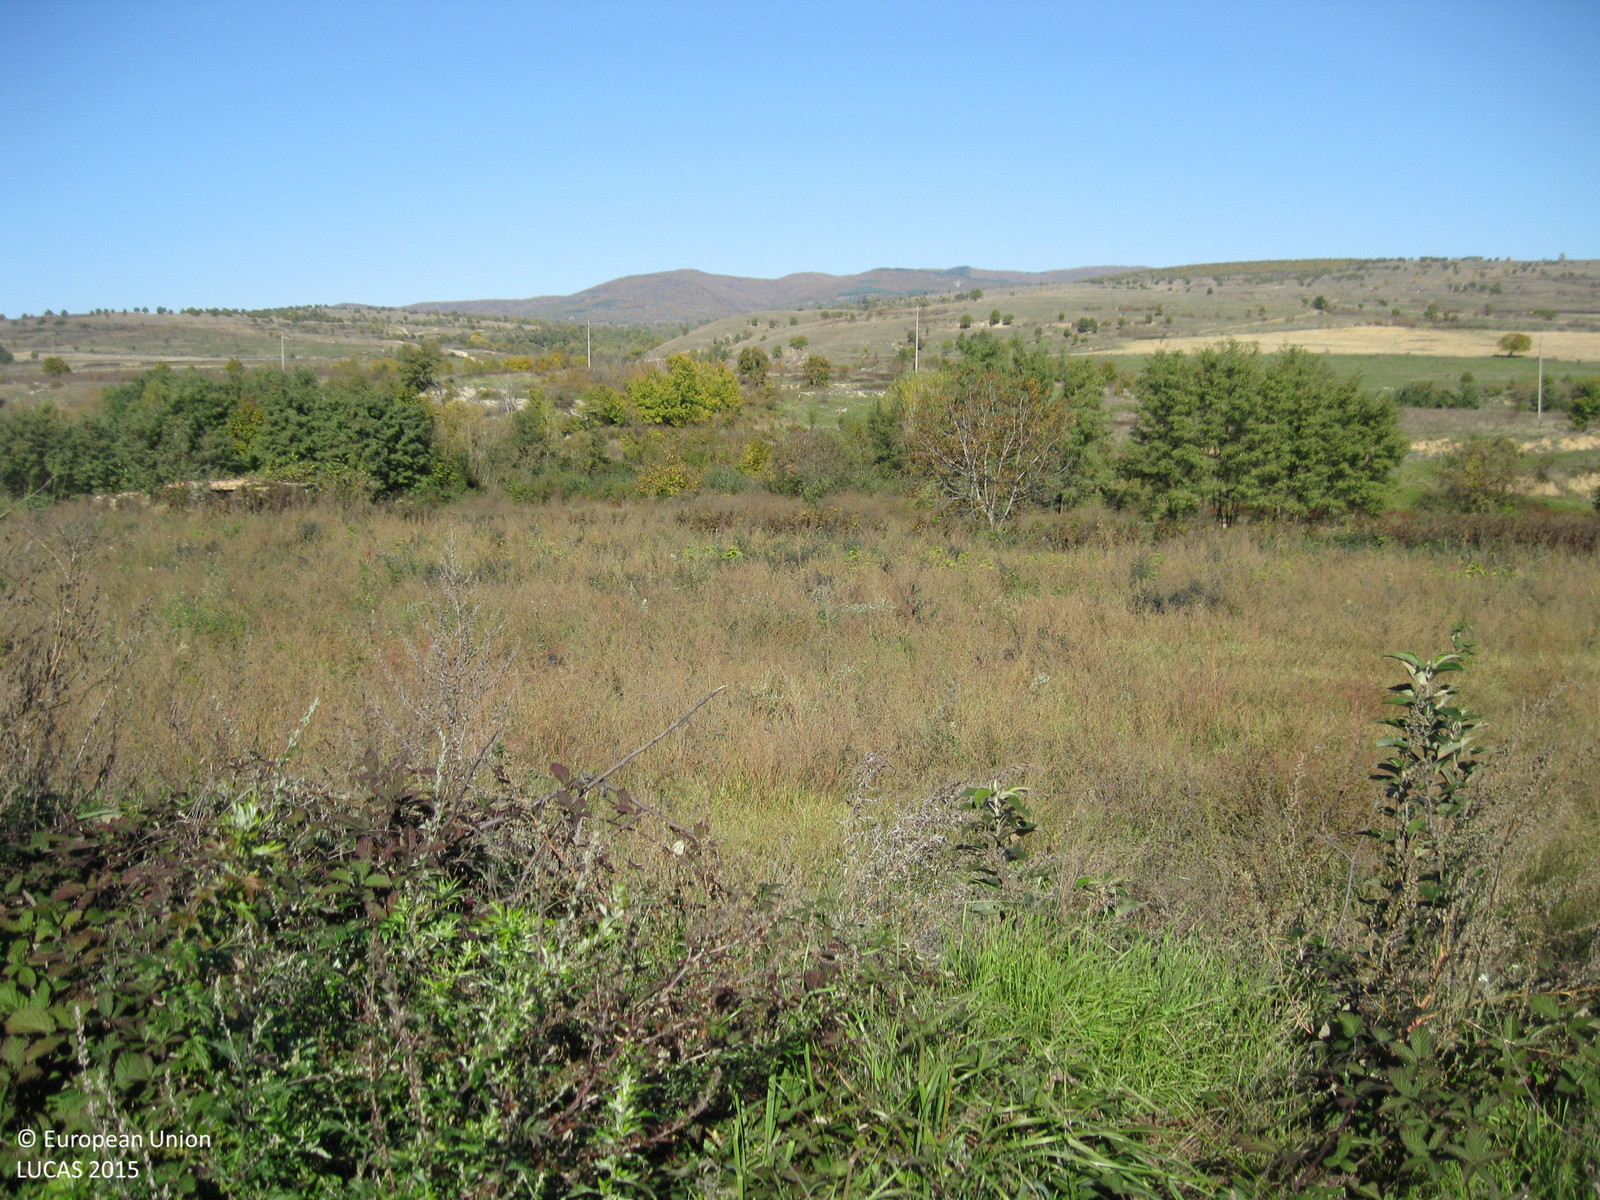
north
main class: Shrubland
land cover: Shrubland without tree cover
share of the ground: > 75 %
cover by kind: shrubs 90 %, herbaceous plants 10 %
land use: Fallow land
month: November
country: BG
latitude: 42.3591
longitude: 24.0900
